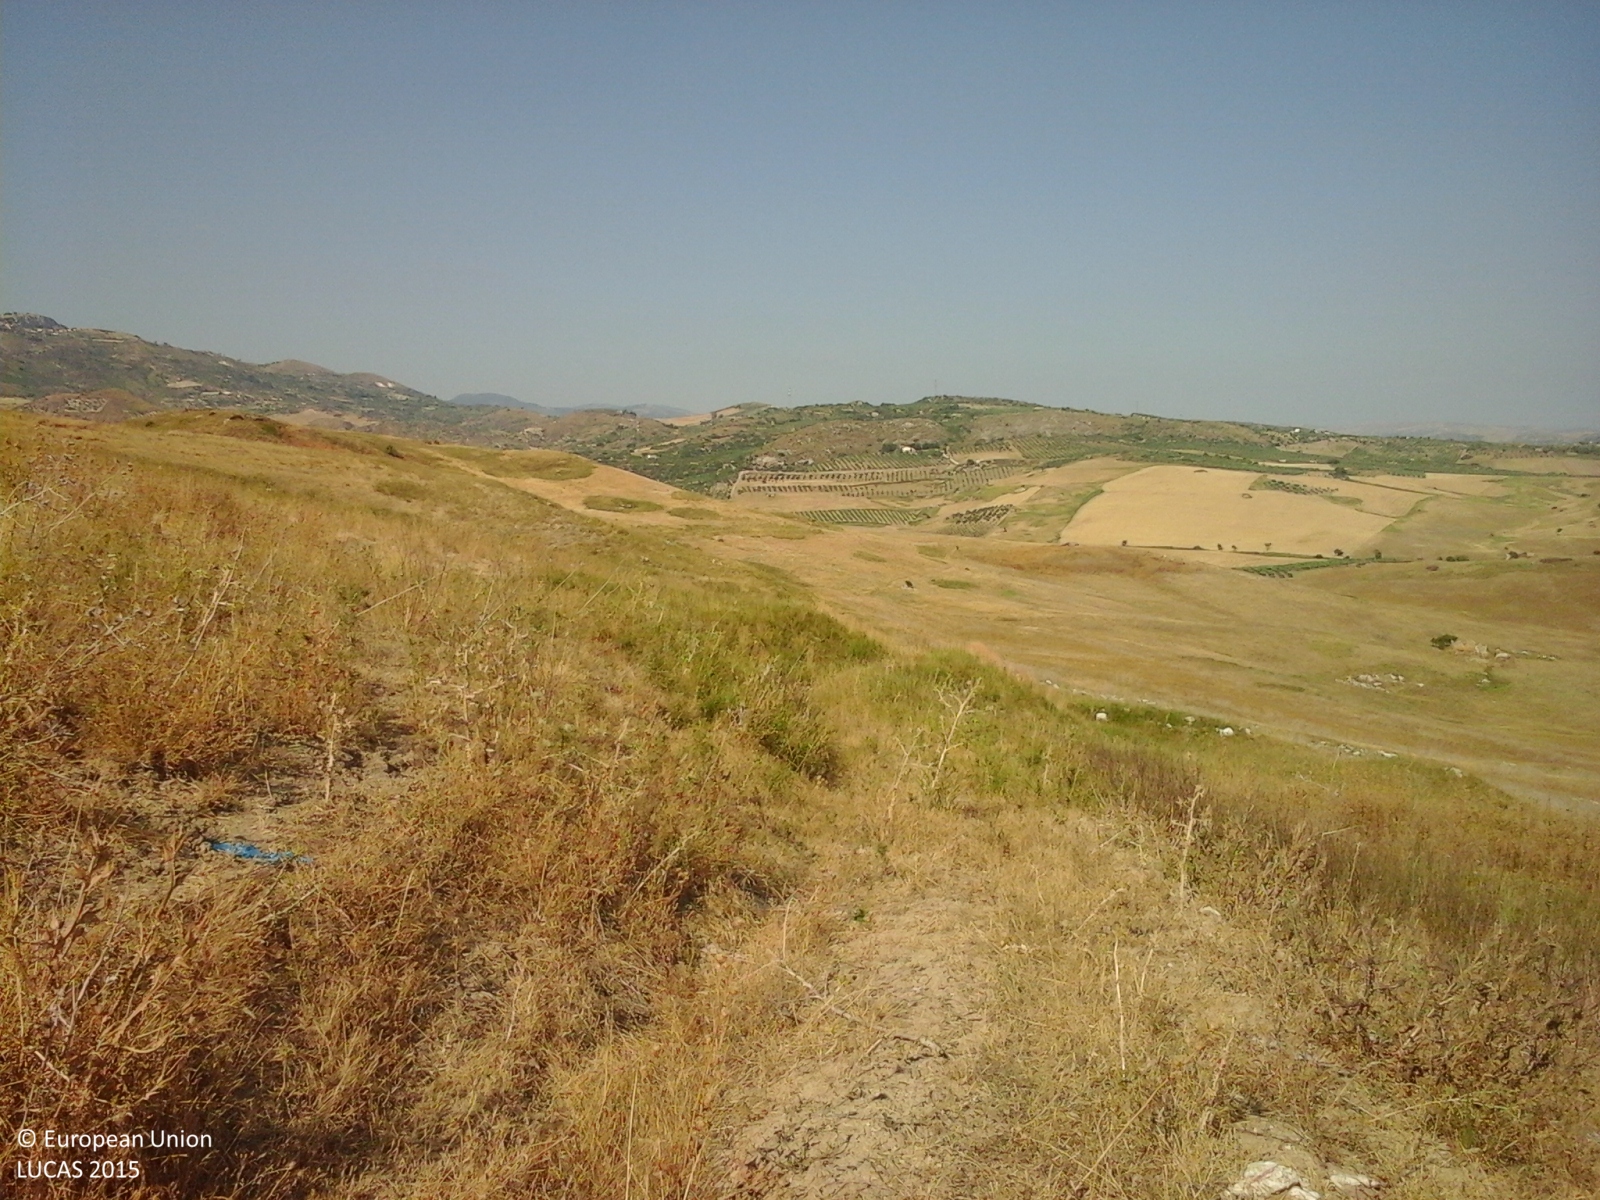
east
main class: Grassland
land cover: Grassland without tree/shrub cover
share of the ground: > 75 %
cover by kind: herbaceous plants 100 %
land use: Agriculture (excluding fallow land and kitchen gardens)
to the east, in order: Grassland without tree/shrub cover; Ditches and canals; Grassland without tree/shrub cover; Temporary grasslands; Tracks; Grassland without tree/shrub cover
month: July
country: IT
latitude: 37.5309
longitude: 13.1782
